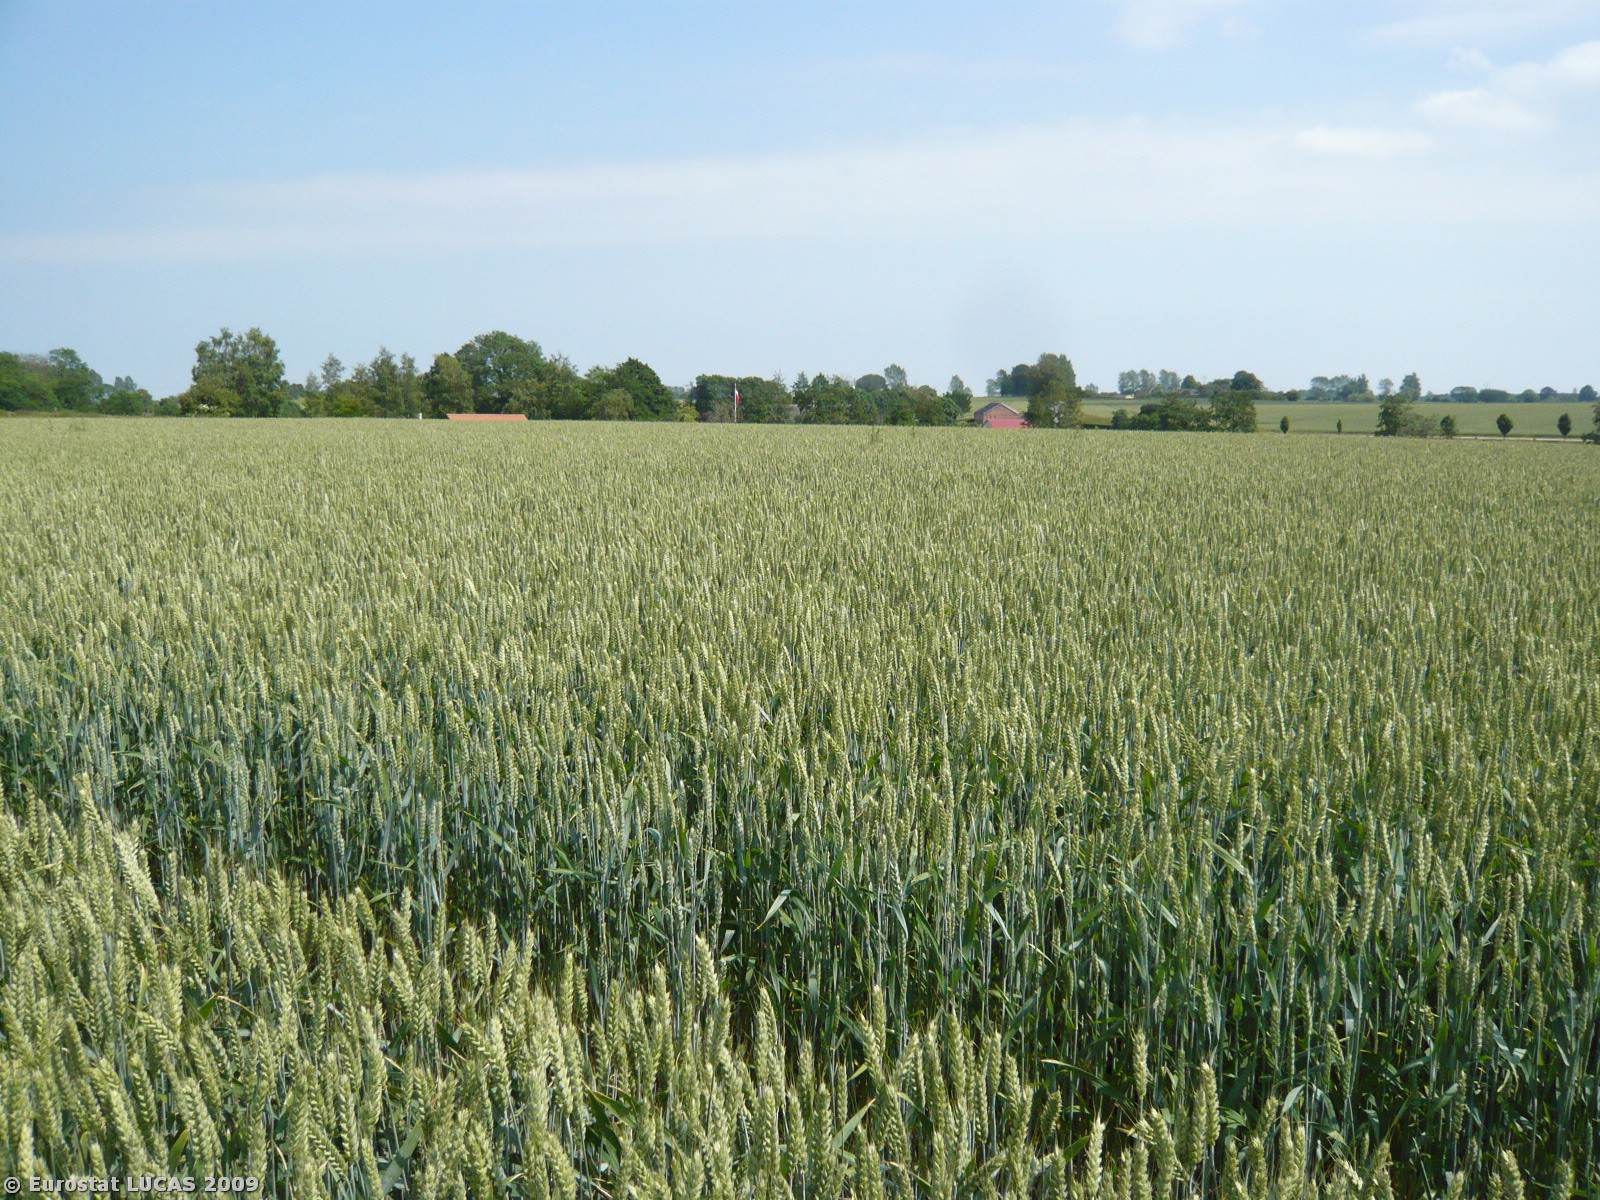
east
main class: Cropland
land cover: Common wheat
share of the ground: > 75 %
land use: Agriculture (excluding fallow land and kitchen gardens)
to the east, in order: Common wheat; Fences; Grassland without tree/shrub cover; Tracks; Grassland without tree/shrub cover; Fences; Grass margins; Rivers and streams; Broadleaved woodland; Paved roads, cycling and walking lanes; Artificial constructions in urban areas; Fences; Grassland without tree/shrub cover
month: June
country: DK
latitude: 55.2874
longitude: 10.6450
